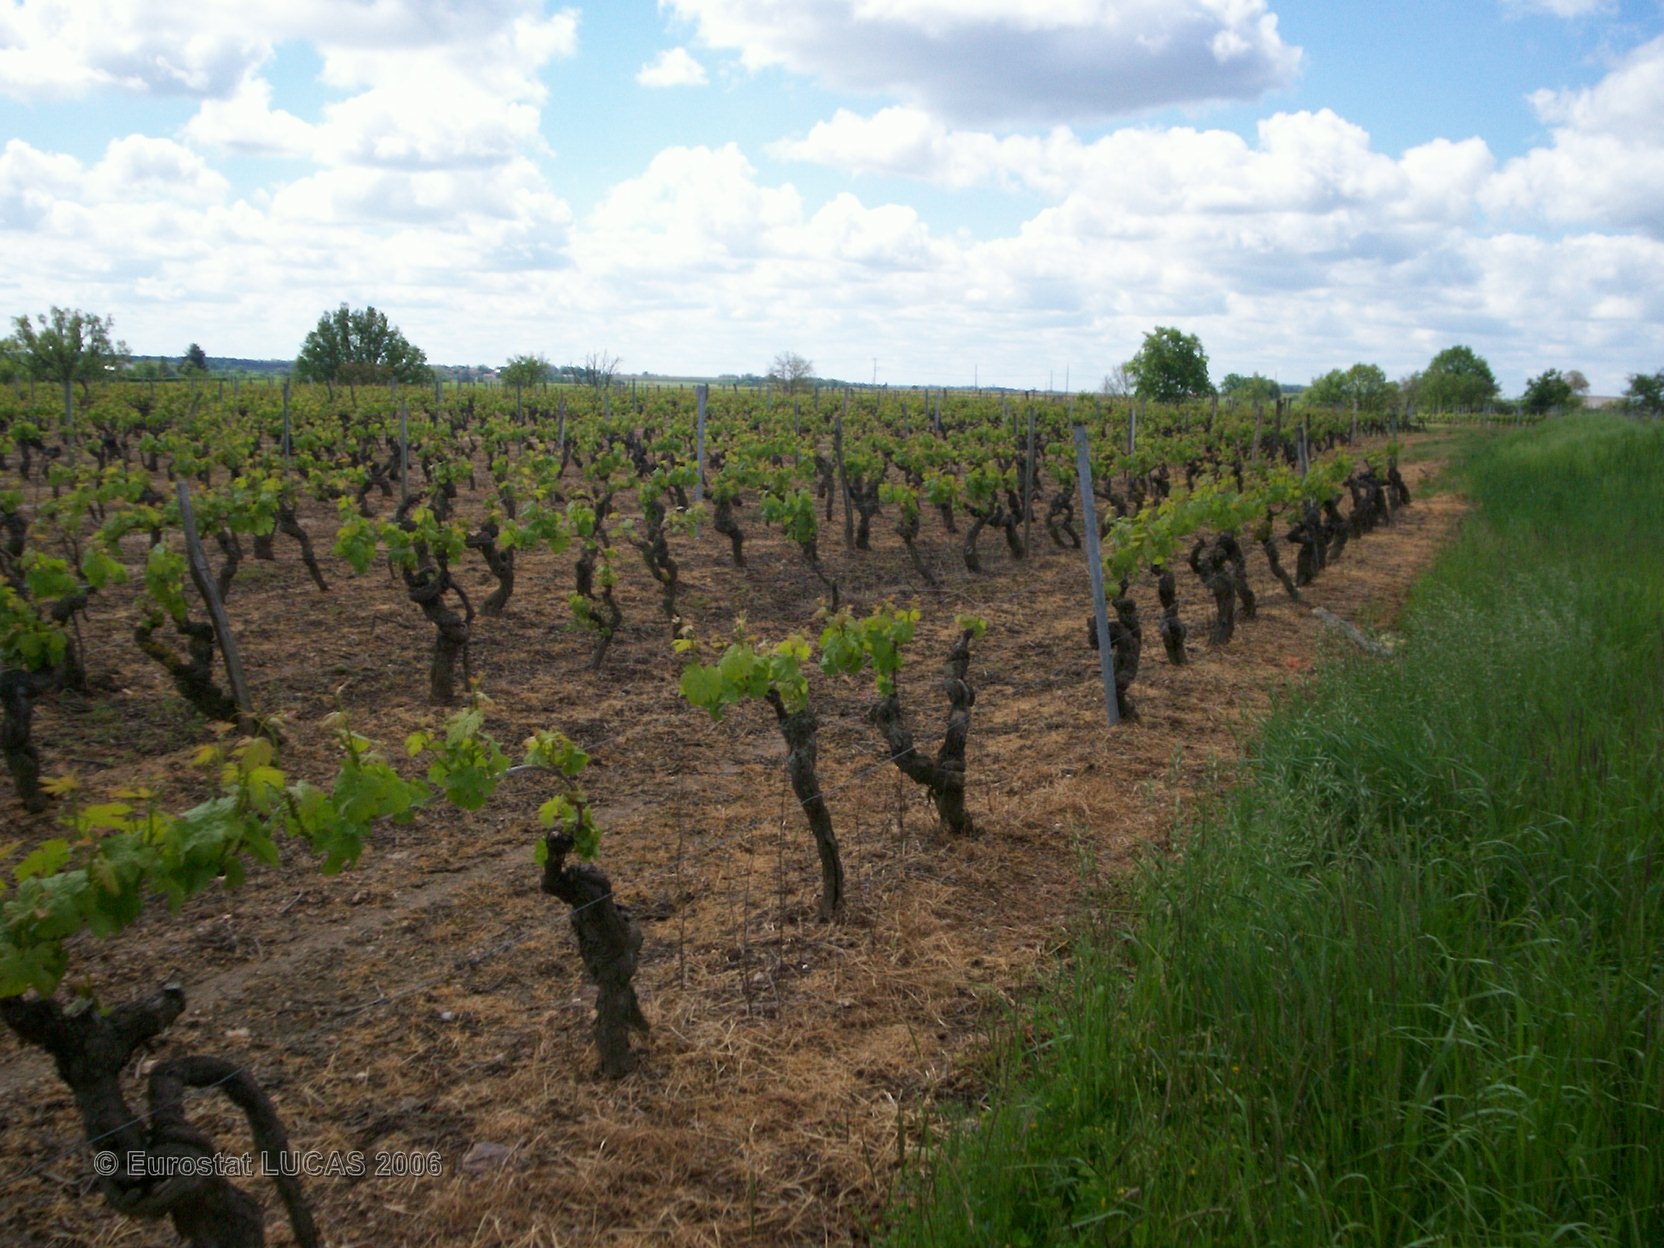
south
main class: Grassland
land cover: Grassland without tree/shrub cover
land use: Agriculture (excluding fallow land and kitchen gardens)
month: May
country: FR
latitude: 47.1362
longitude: -0.3515
